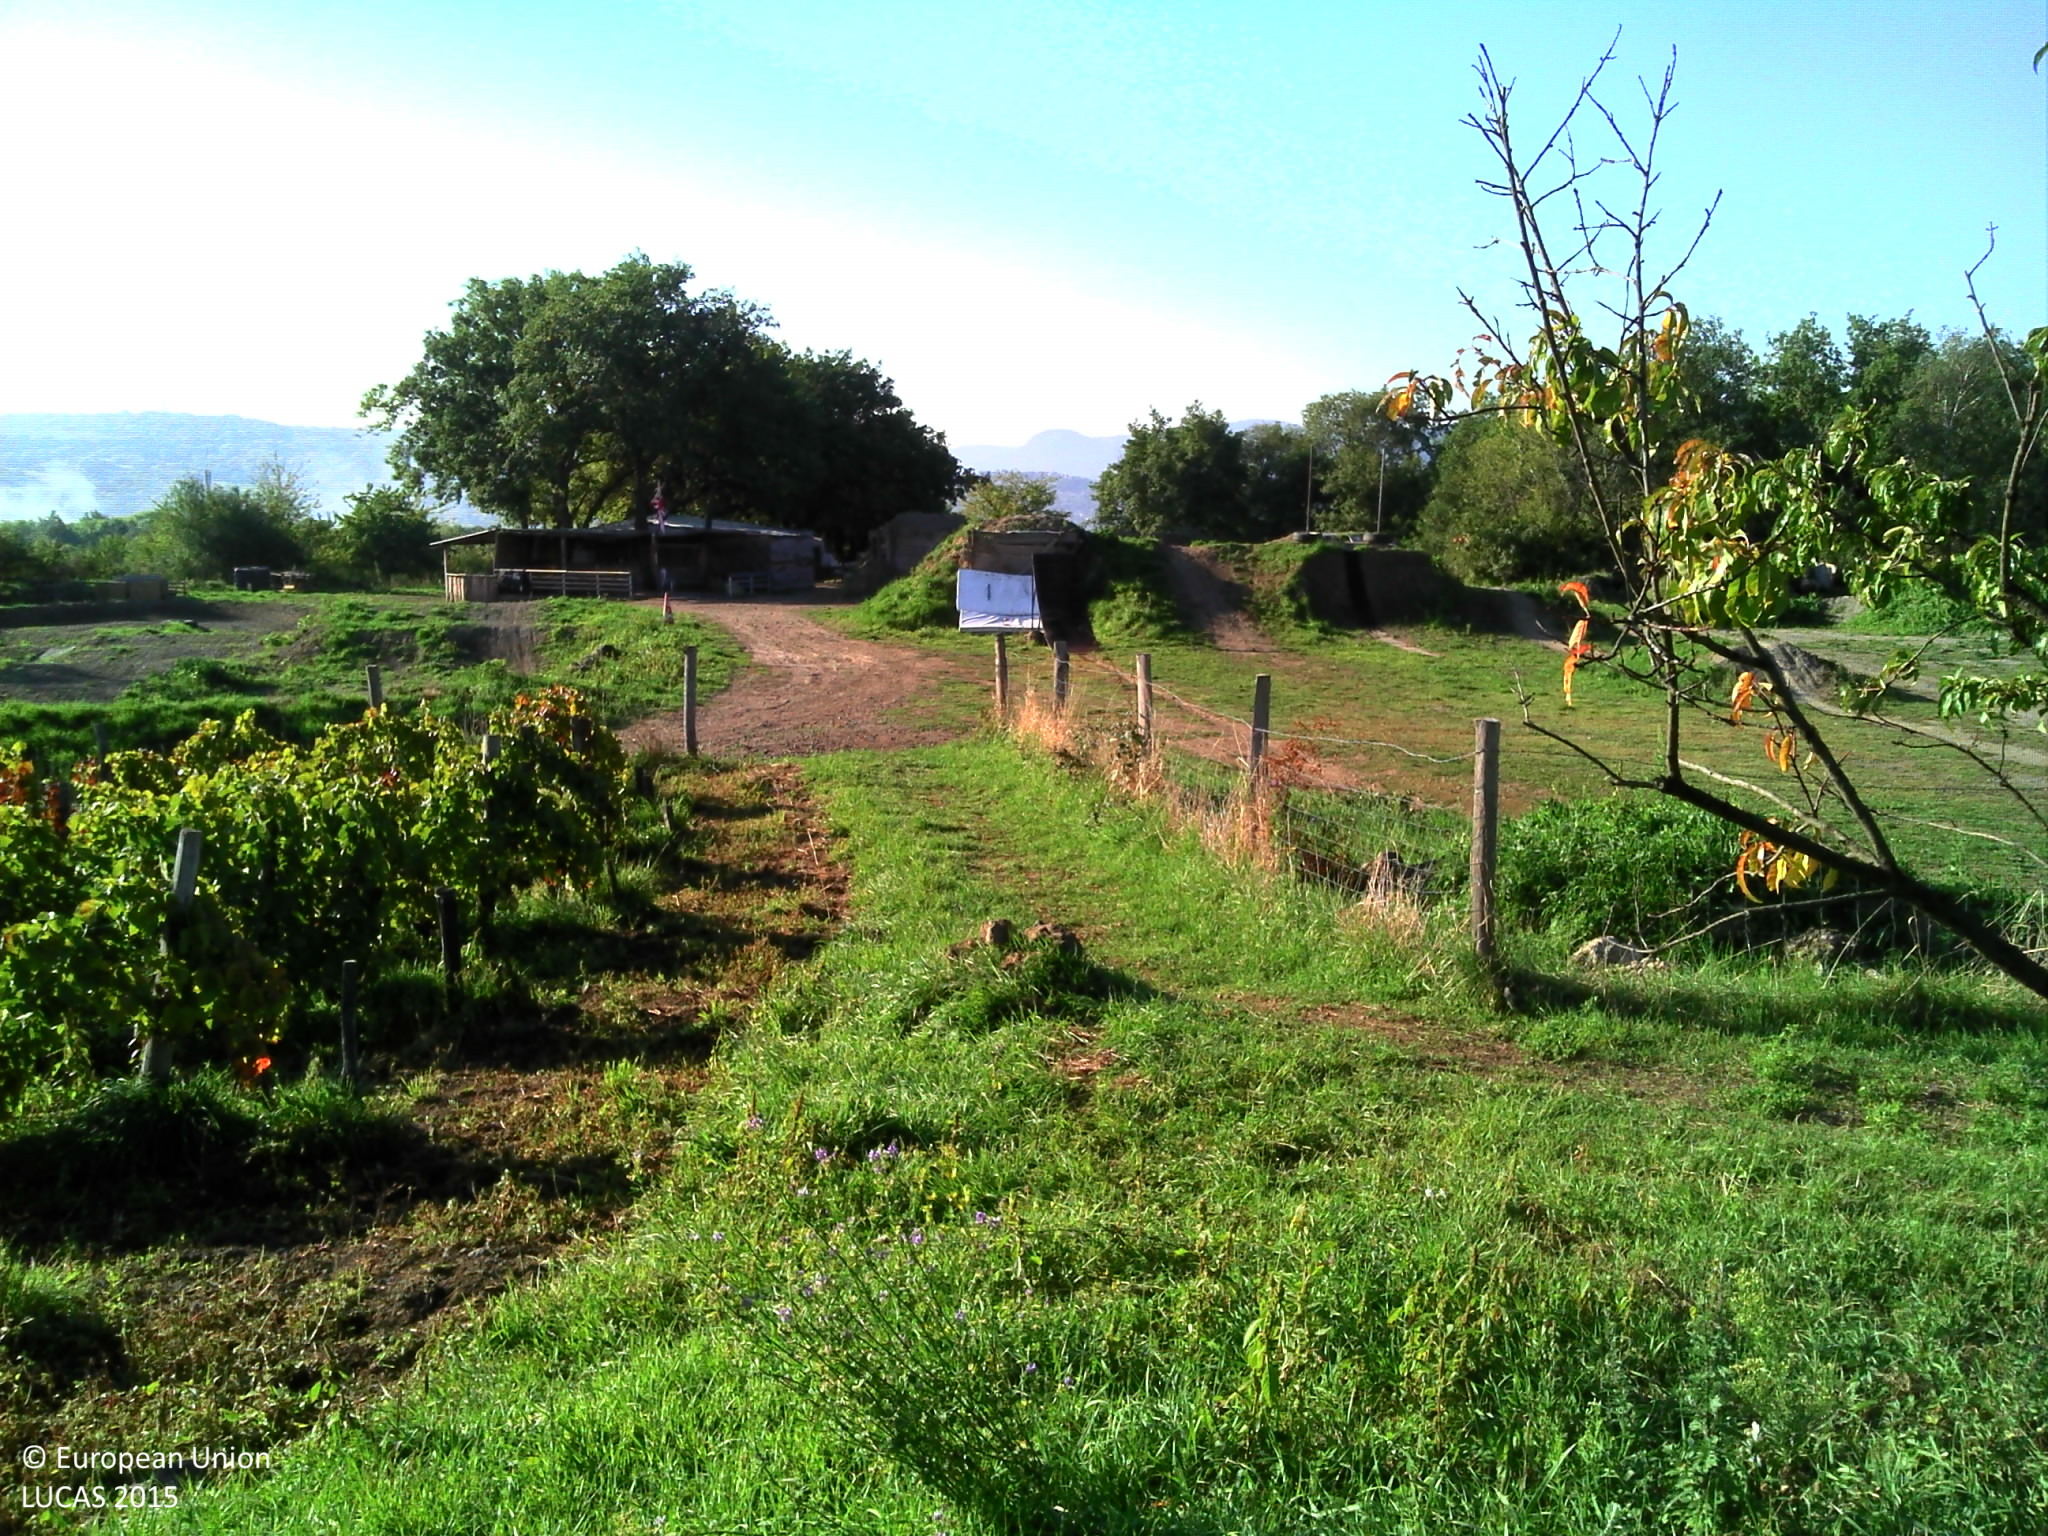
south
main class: Grassland
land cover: Grassland with sparse tree/shrub cover
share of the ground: > 75 %
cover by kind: herbaceous plants 95 %, broadleaved forest trees 5 %
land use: Agriculture (excluding fallow land and kitchen gardens)
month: September
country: FR
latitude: 45.8364
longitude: 3.0600
